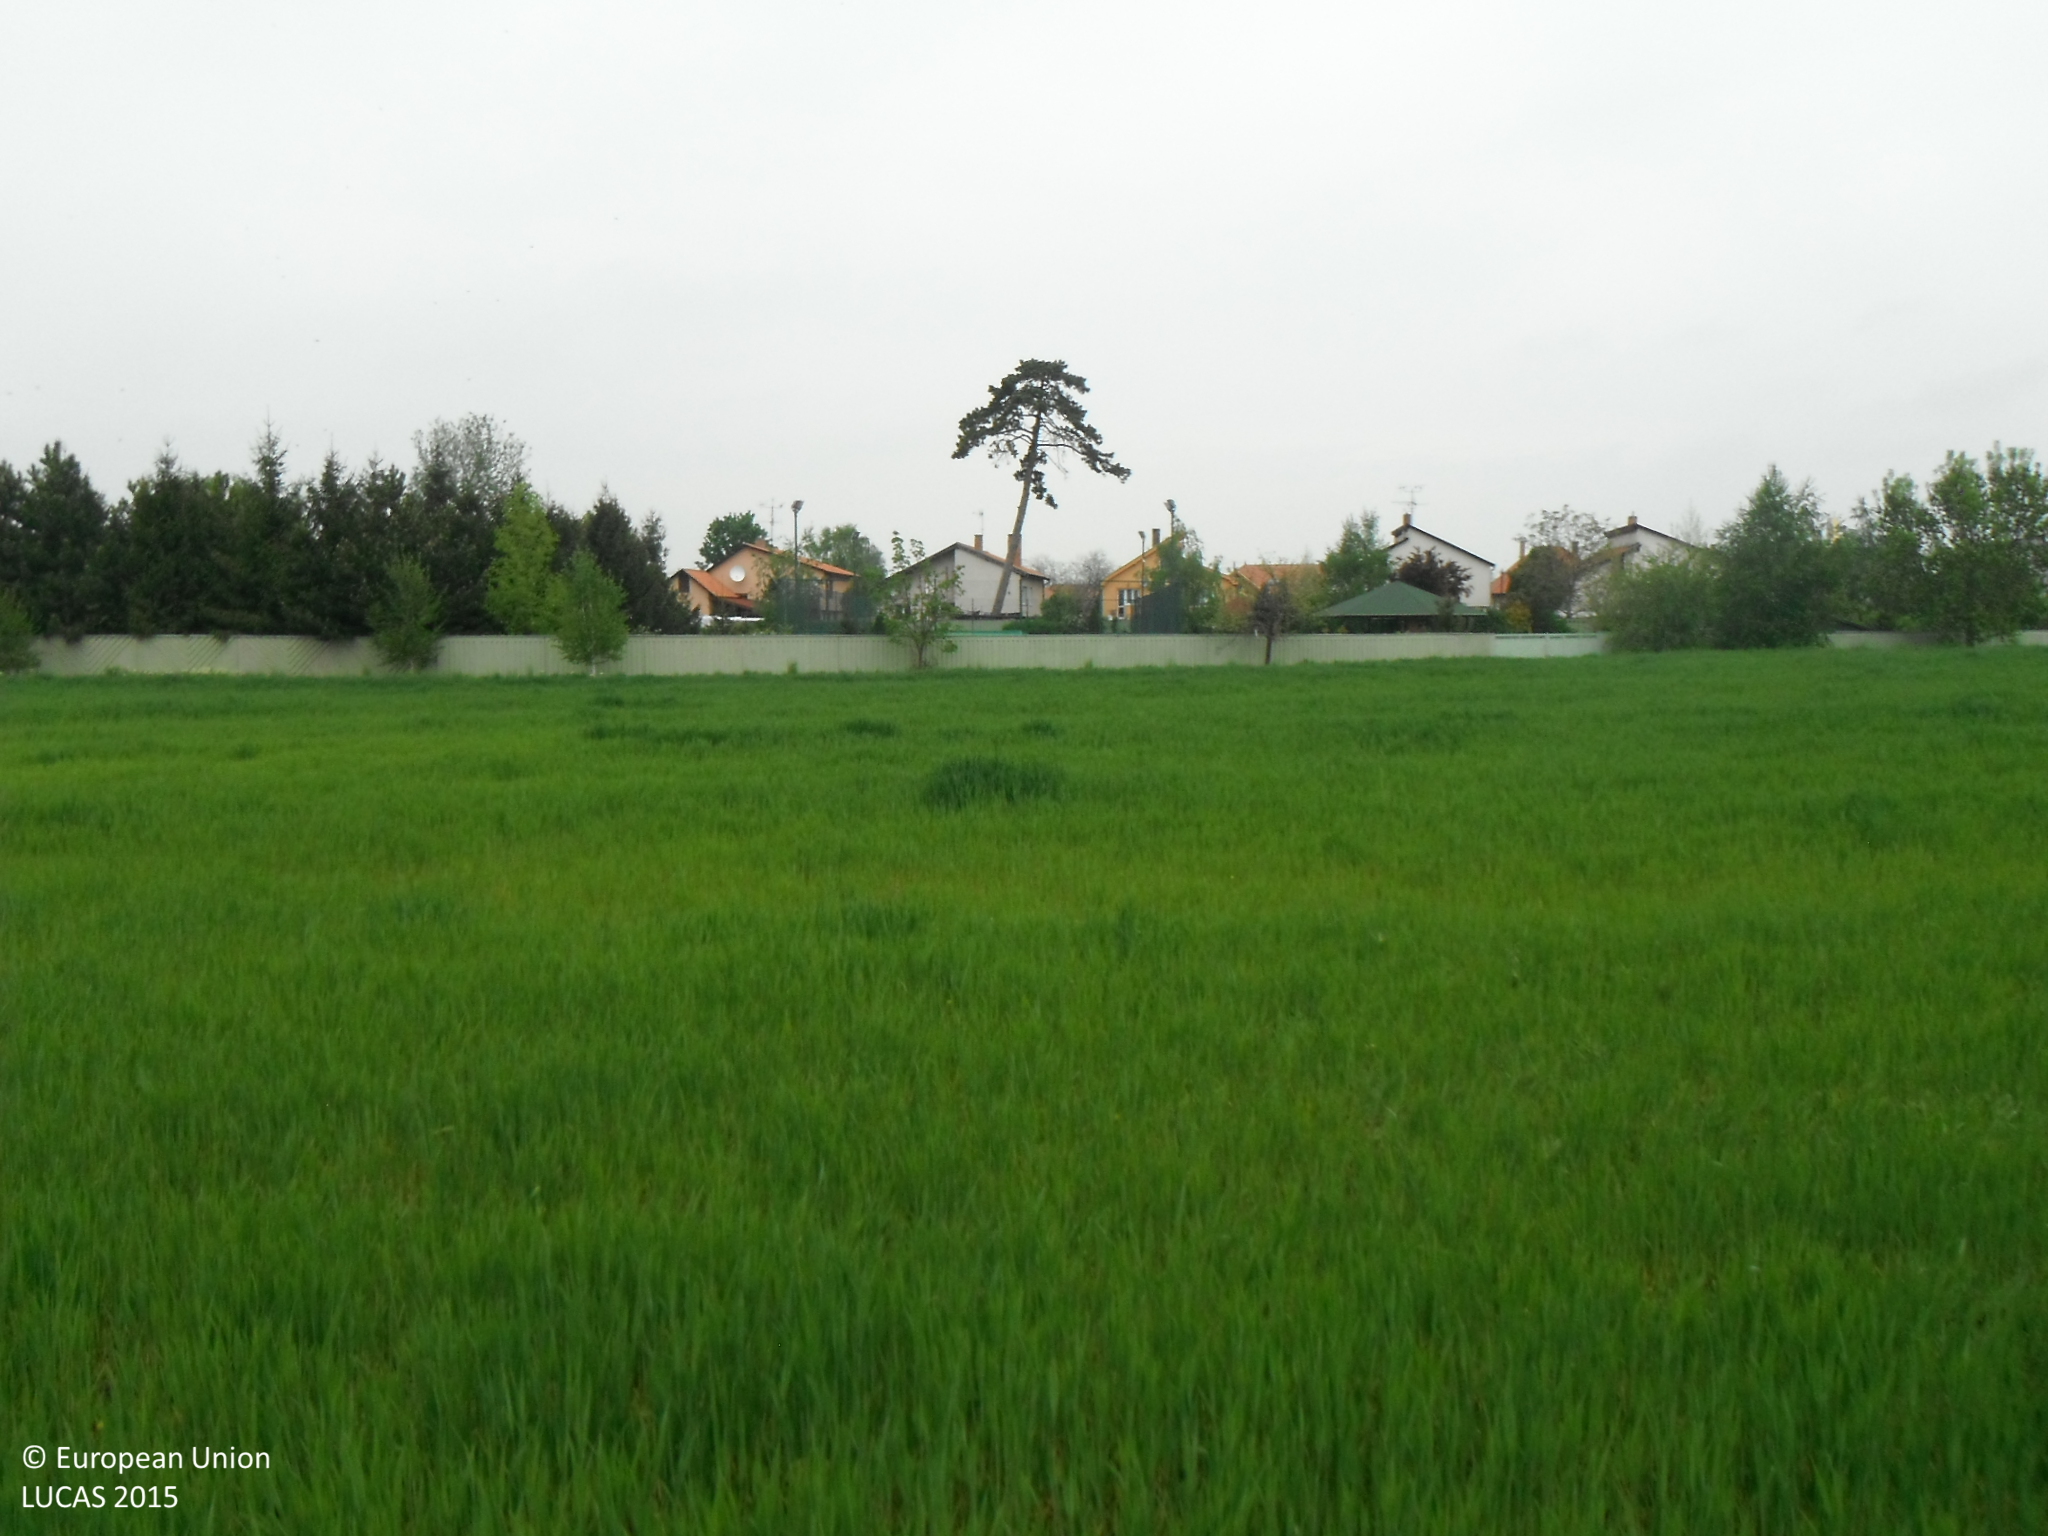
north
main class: Cropland
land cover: Common wheat
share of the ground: > 75 %
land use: Agriculture (excluding fallow land and kitchen gardens)
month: May
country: SK
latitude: 48.1167
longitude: 17.4378
